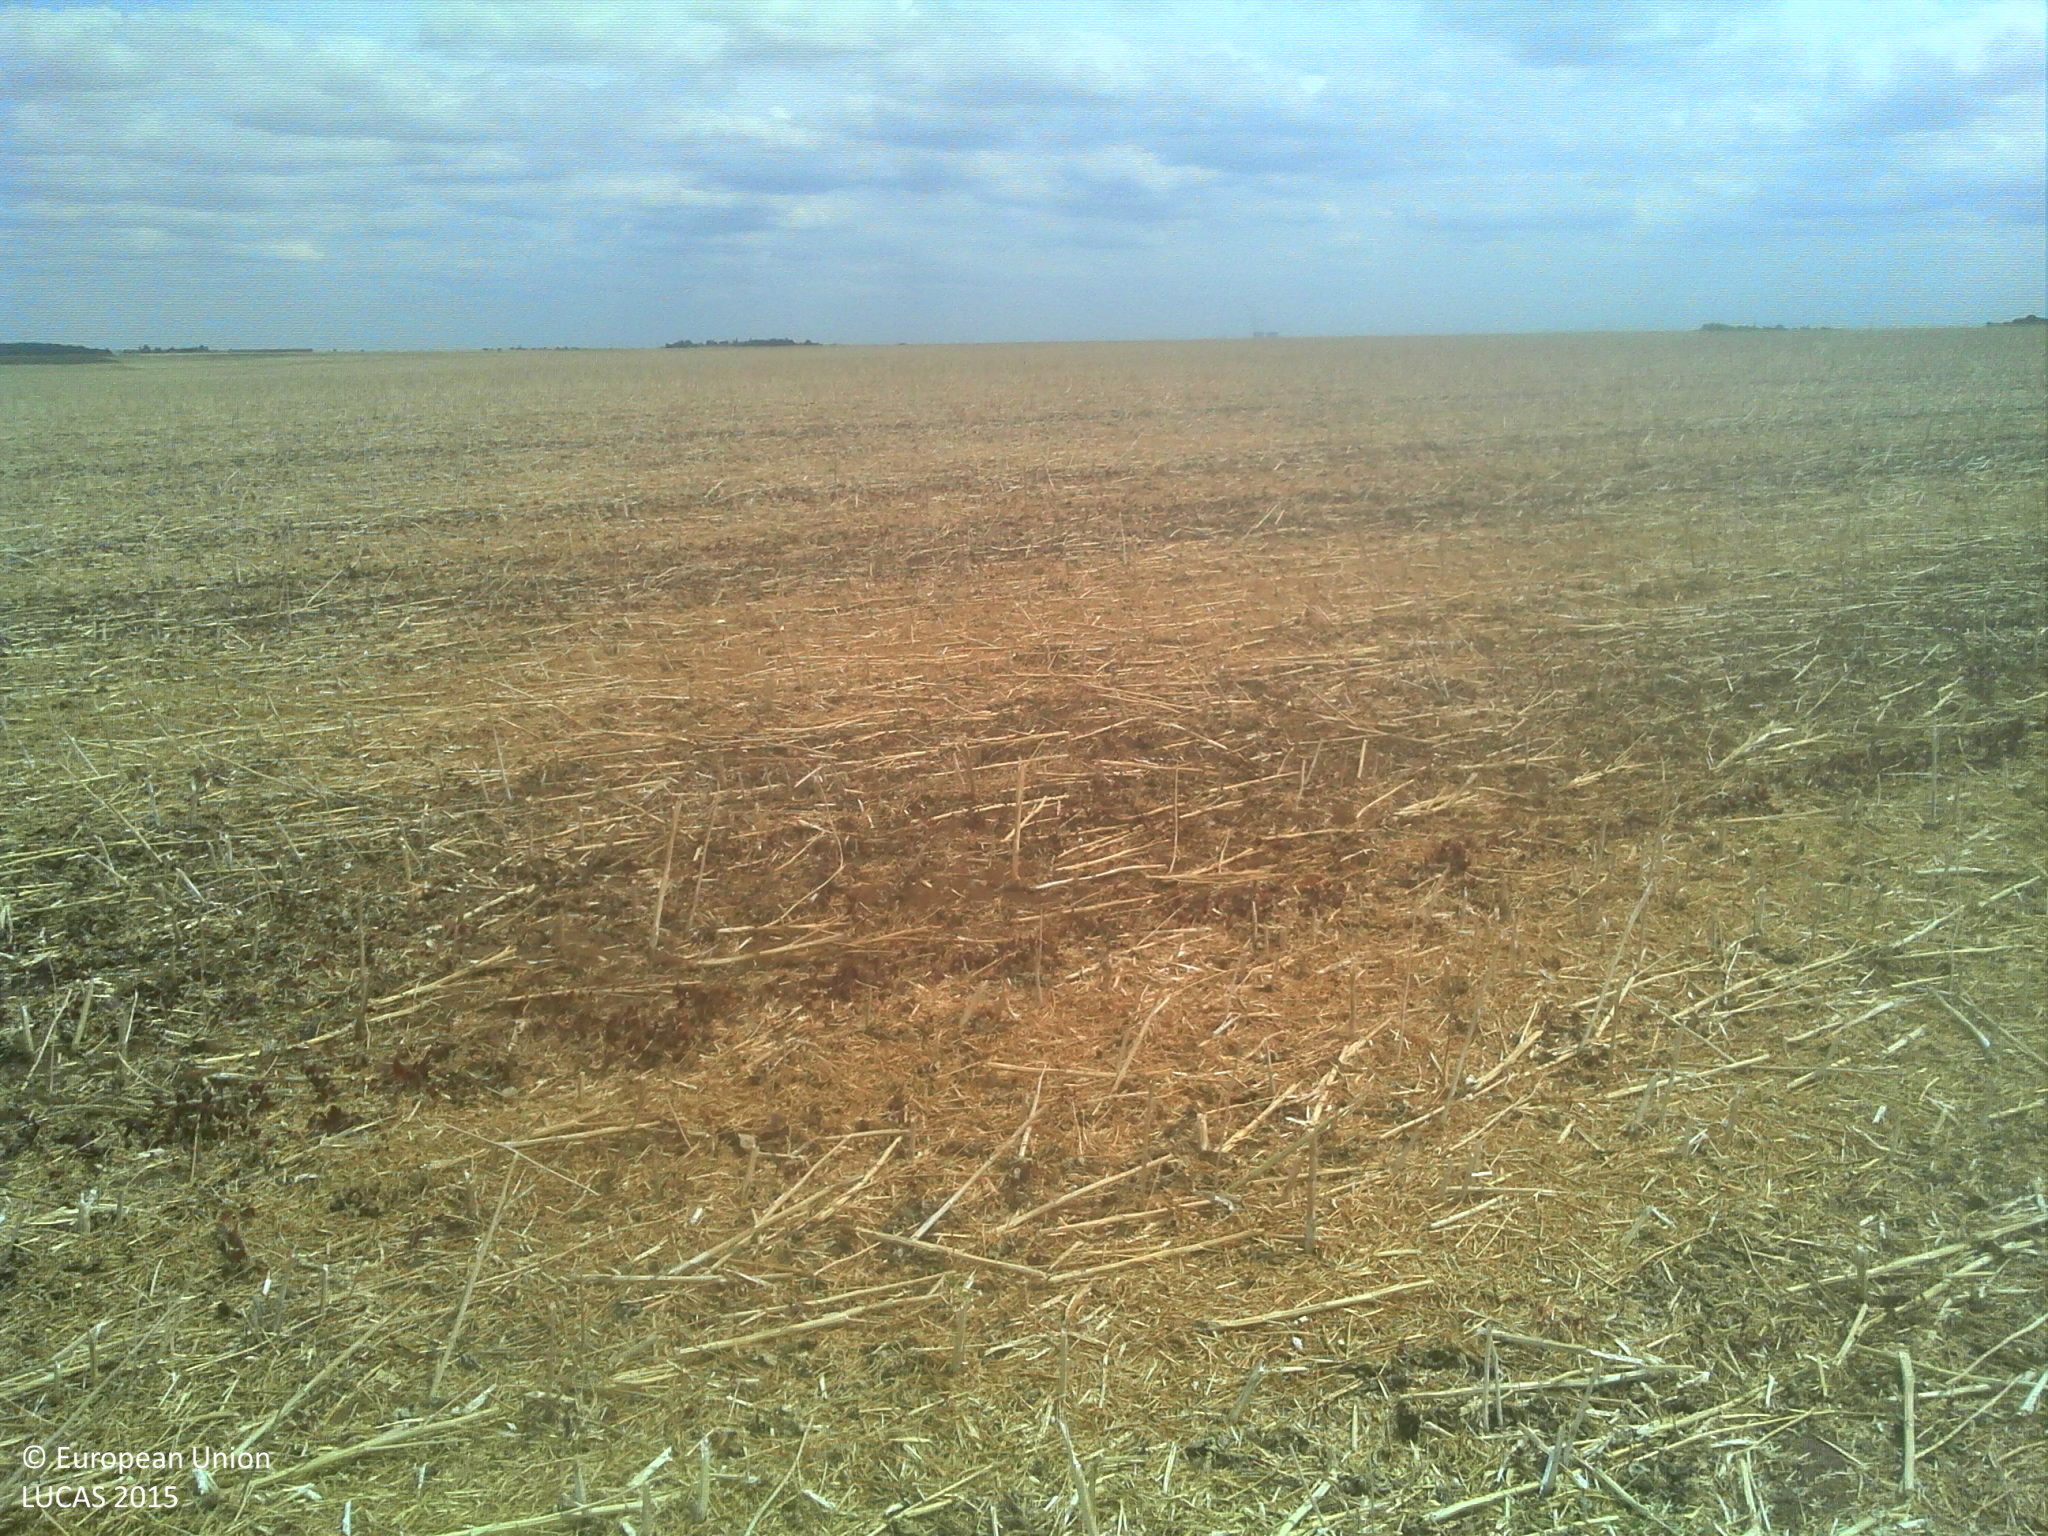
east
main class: Cropland
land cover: Rape and turnip rape
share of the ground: < 10 %
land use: Agriculture (excluding fallow land and kitchen gardens)
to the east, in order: Rape and turnip rape
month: July
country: FR
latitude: 47.7587
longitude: 1.3797
